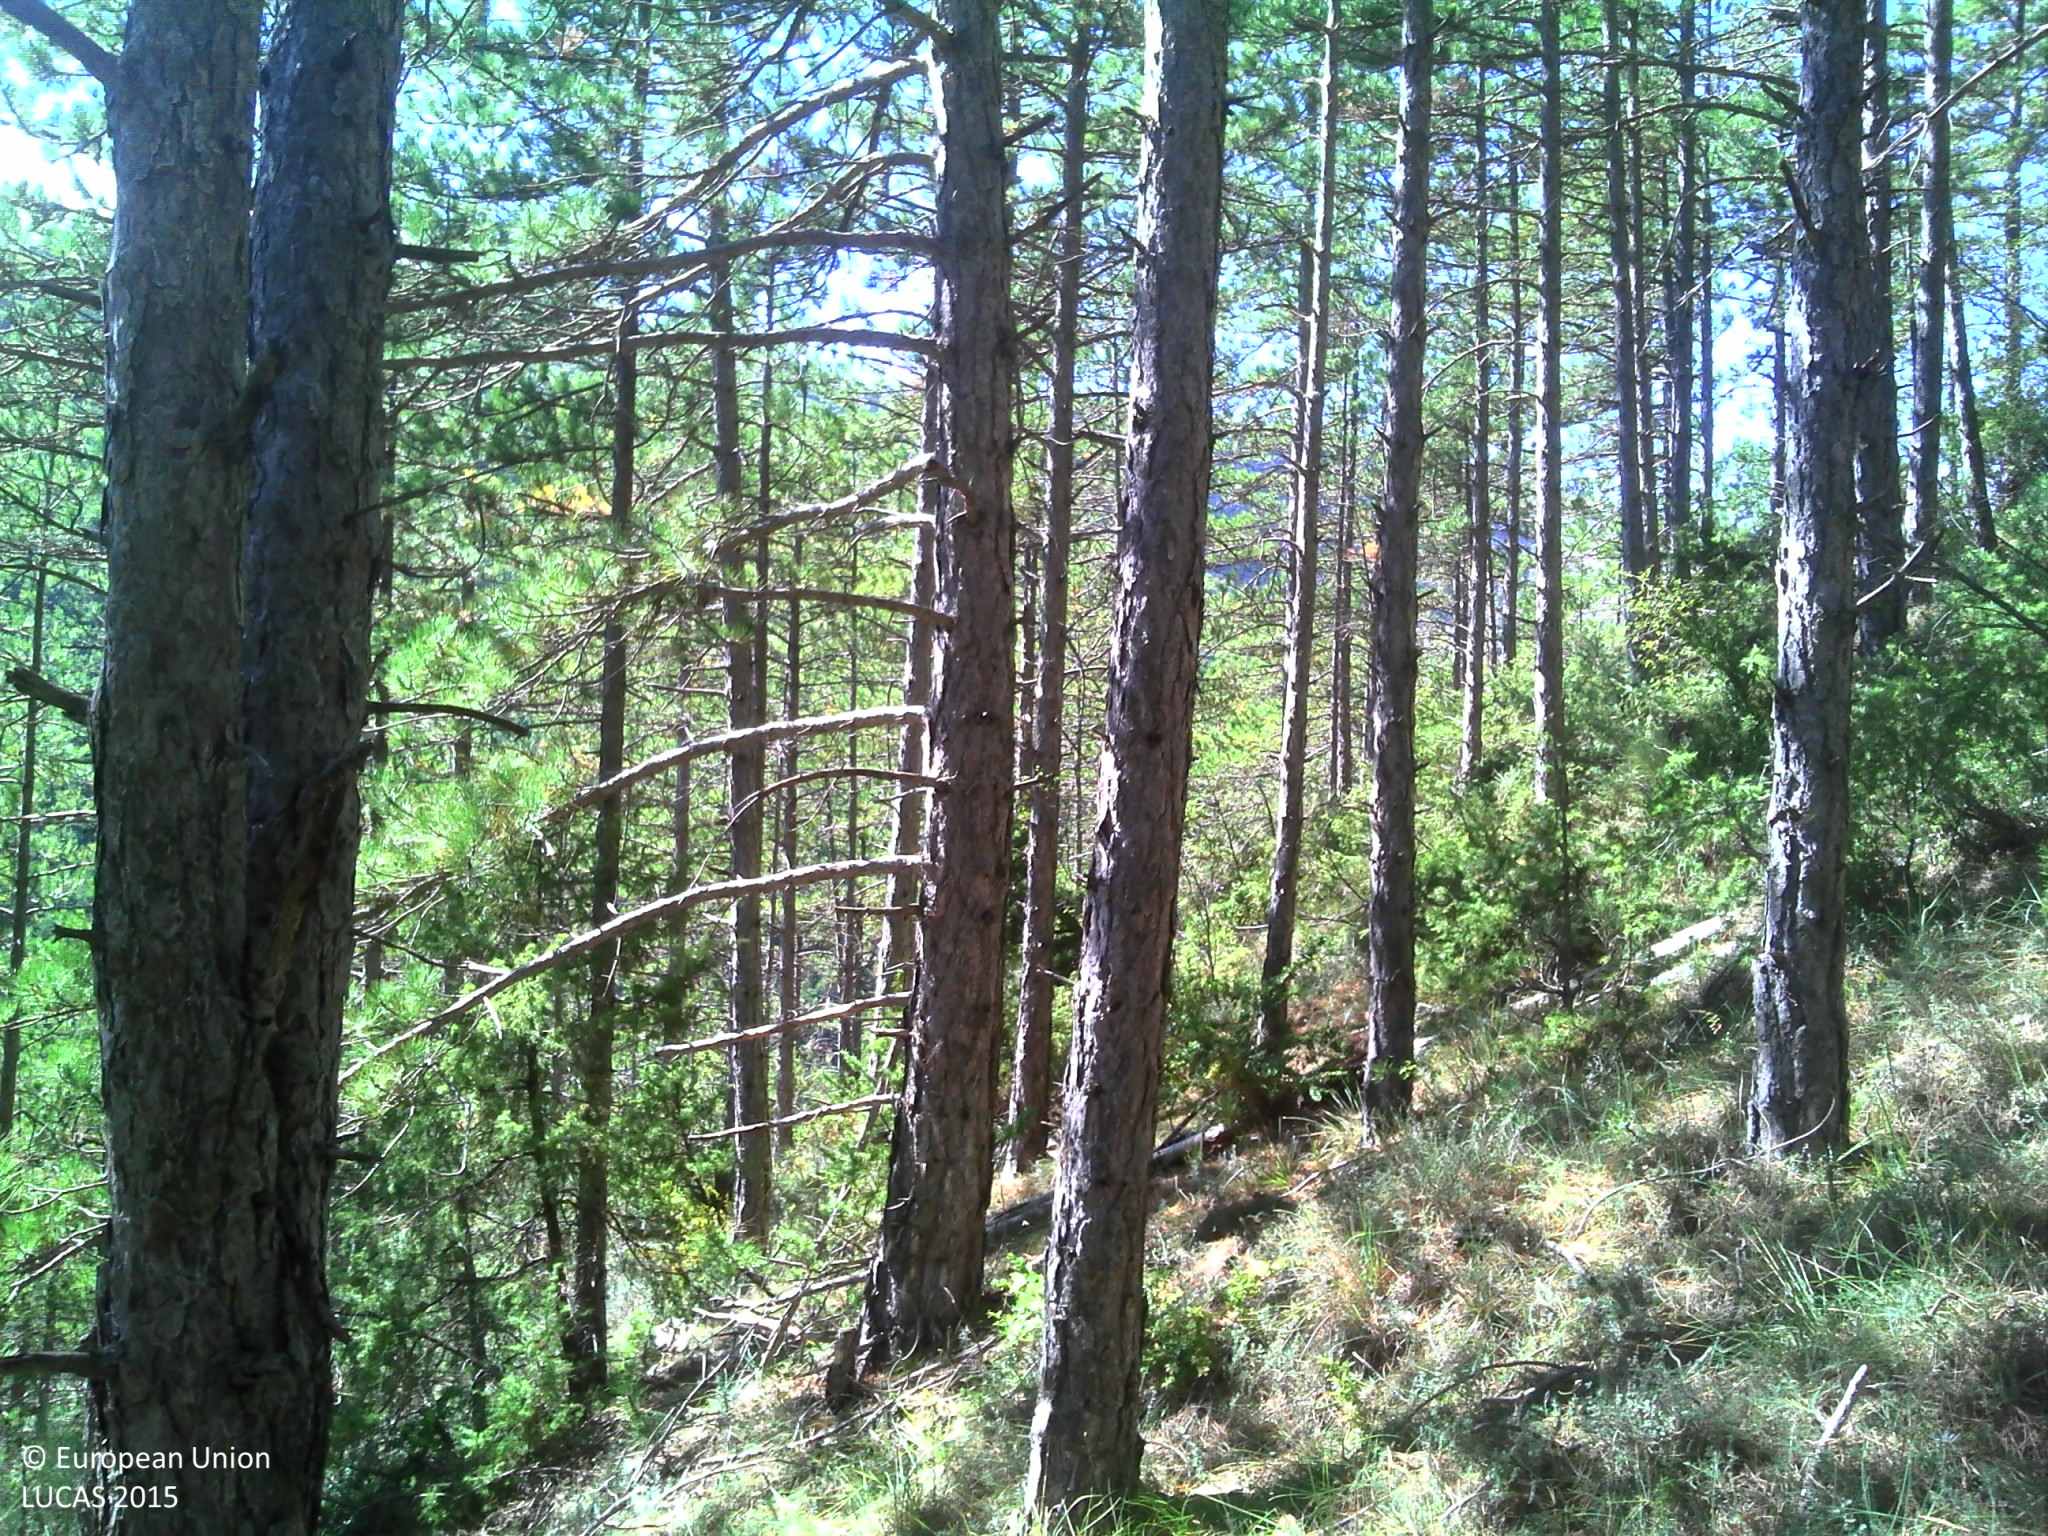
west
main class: Woodland
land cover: Pine dominated coniferous woodland
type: coniferous forest of the mediterranean region
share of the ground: > 75 %
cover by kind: coniferous forest trees 75 %, herbaceous plants 20 %, shrubs 5 %
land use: Forestry
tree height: > 5 m
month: September
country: FR
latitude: 44.2480
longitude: 5.3866
